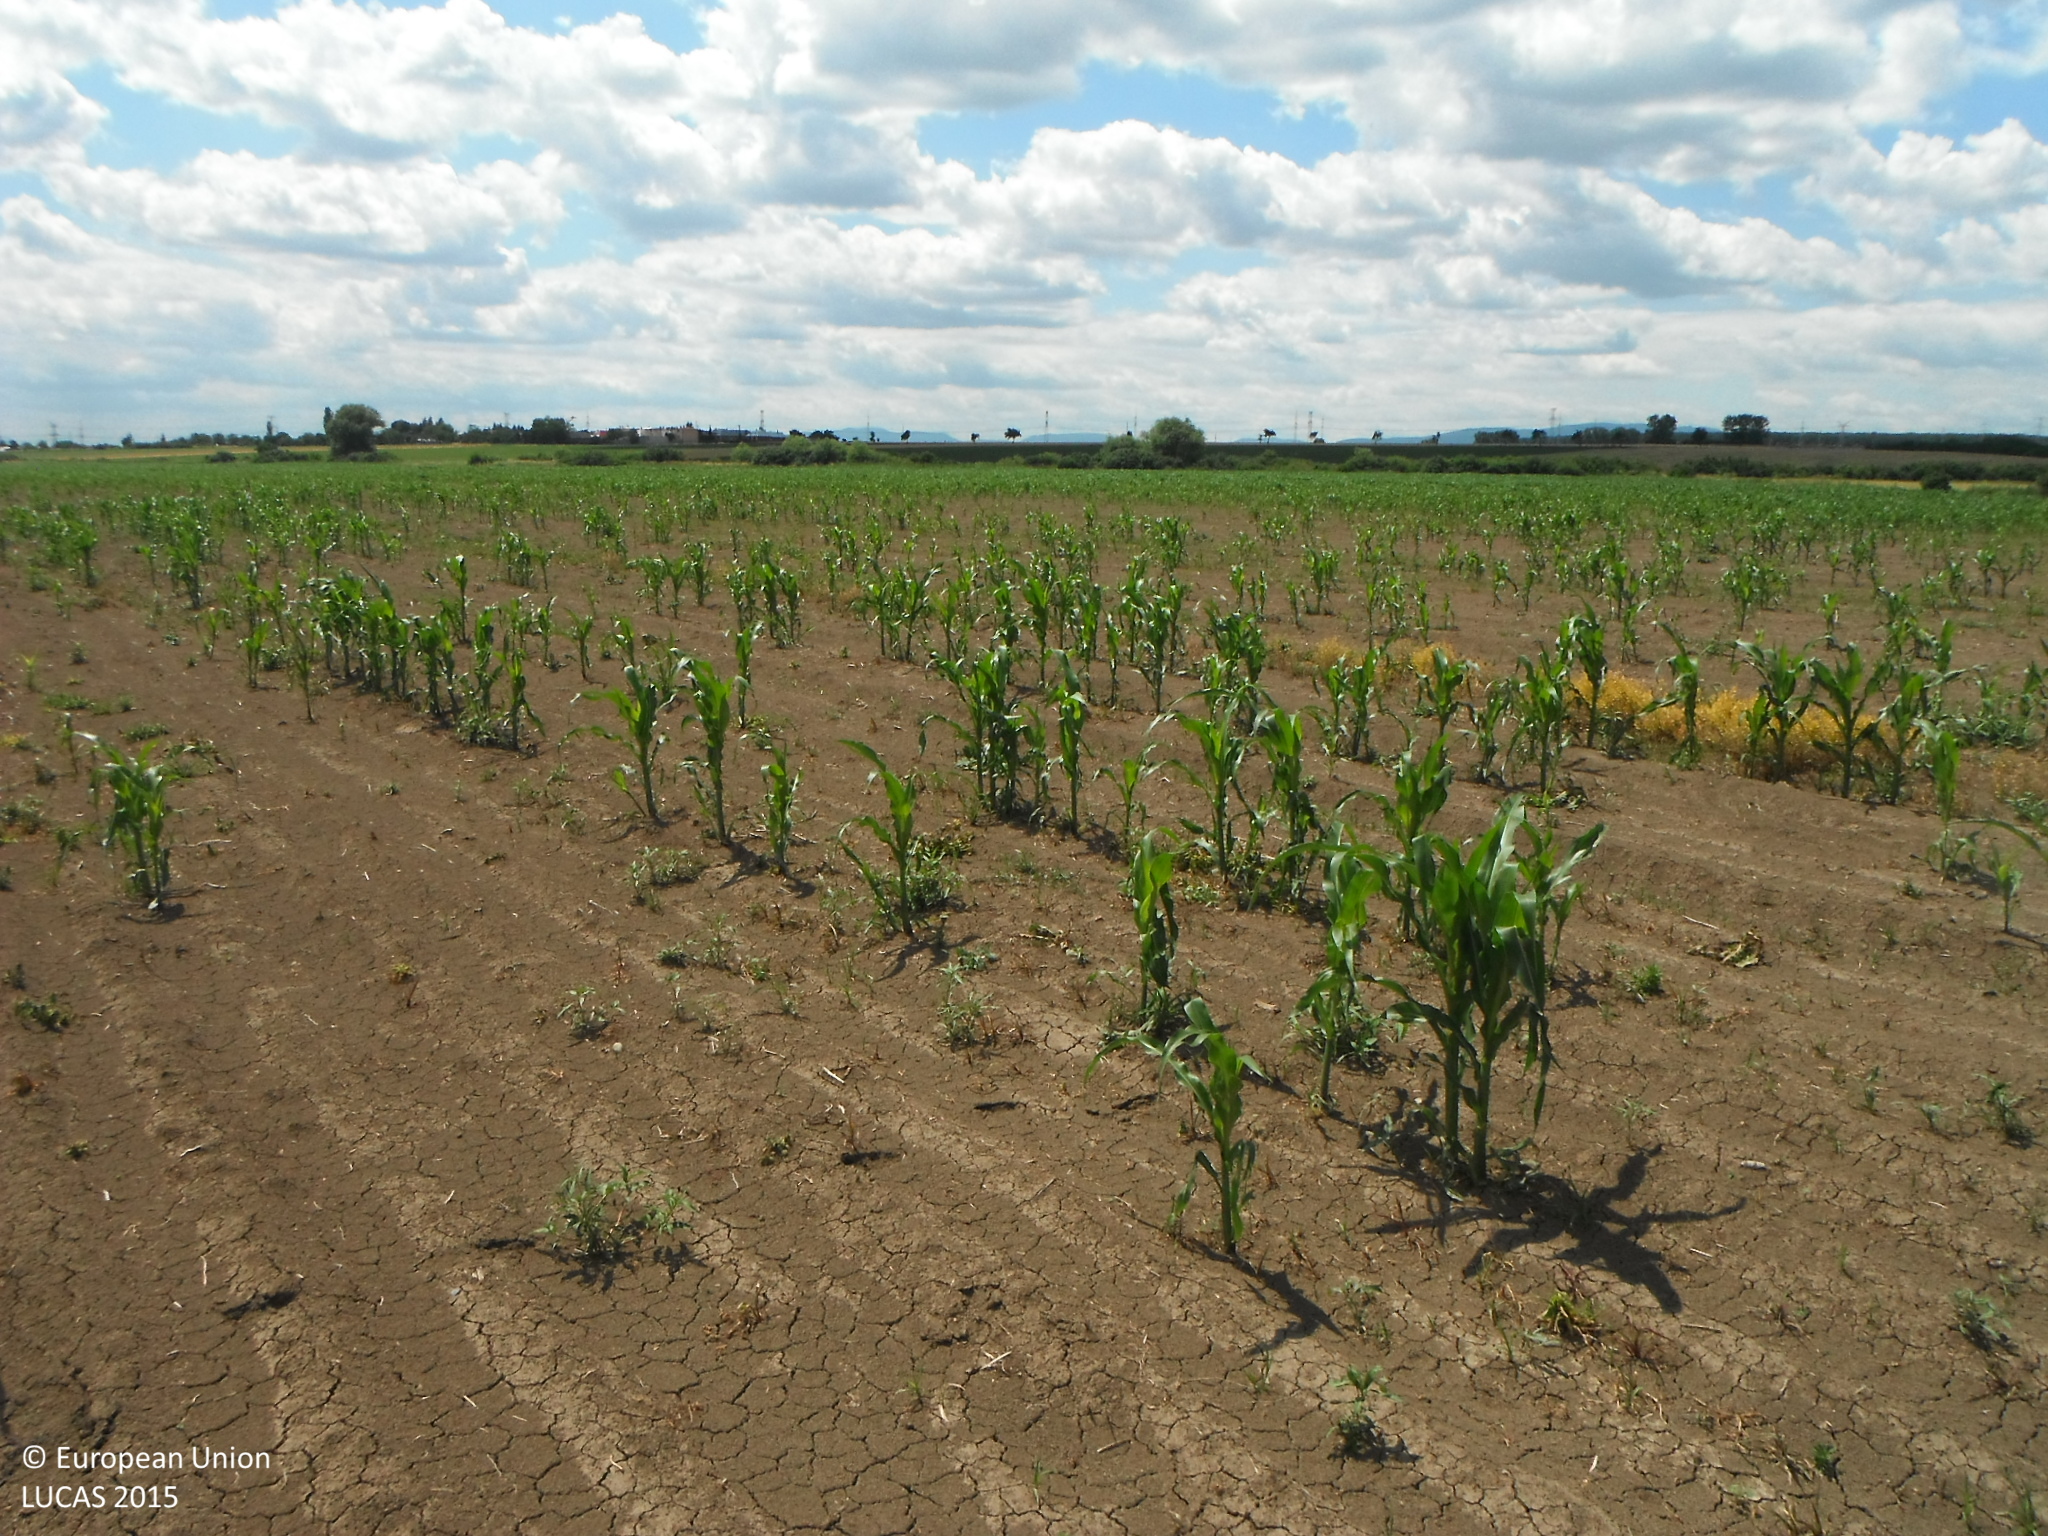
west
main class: Cropland
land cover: Maize
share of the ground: < 10 %
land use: Agriculture (excluding fallow land and kitchen gardens)
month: June
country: SK
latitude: 48.7079
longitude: 21.8619
